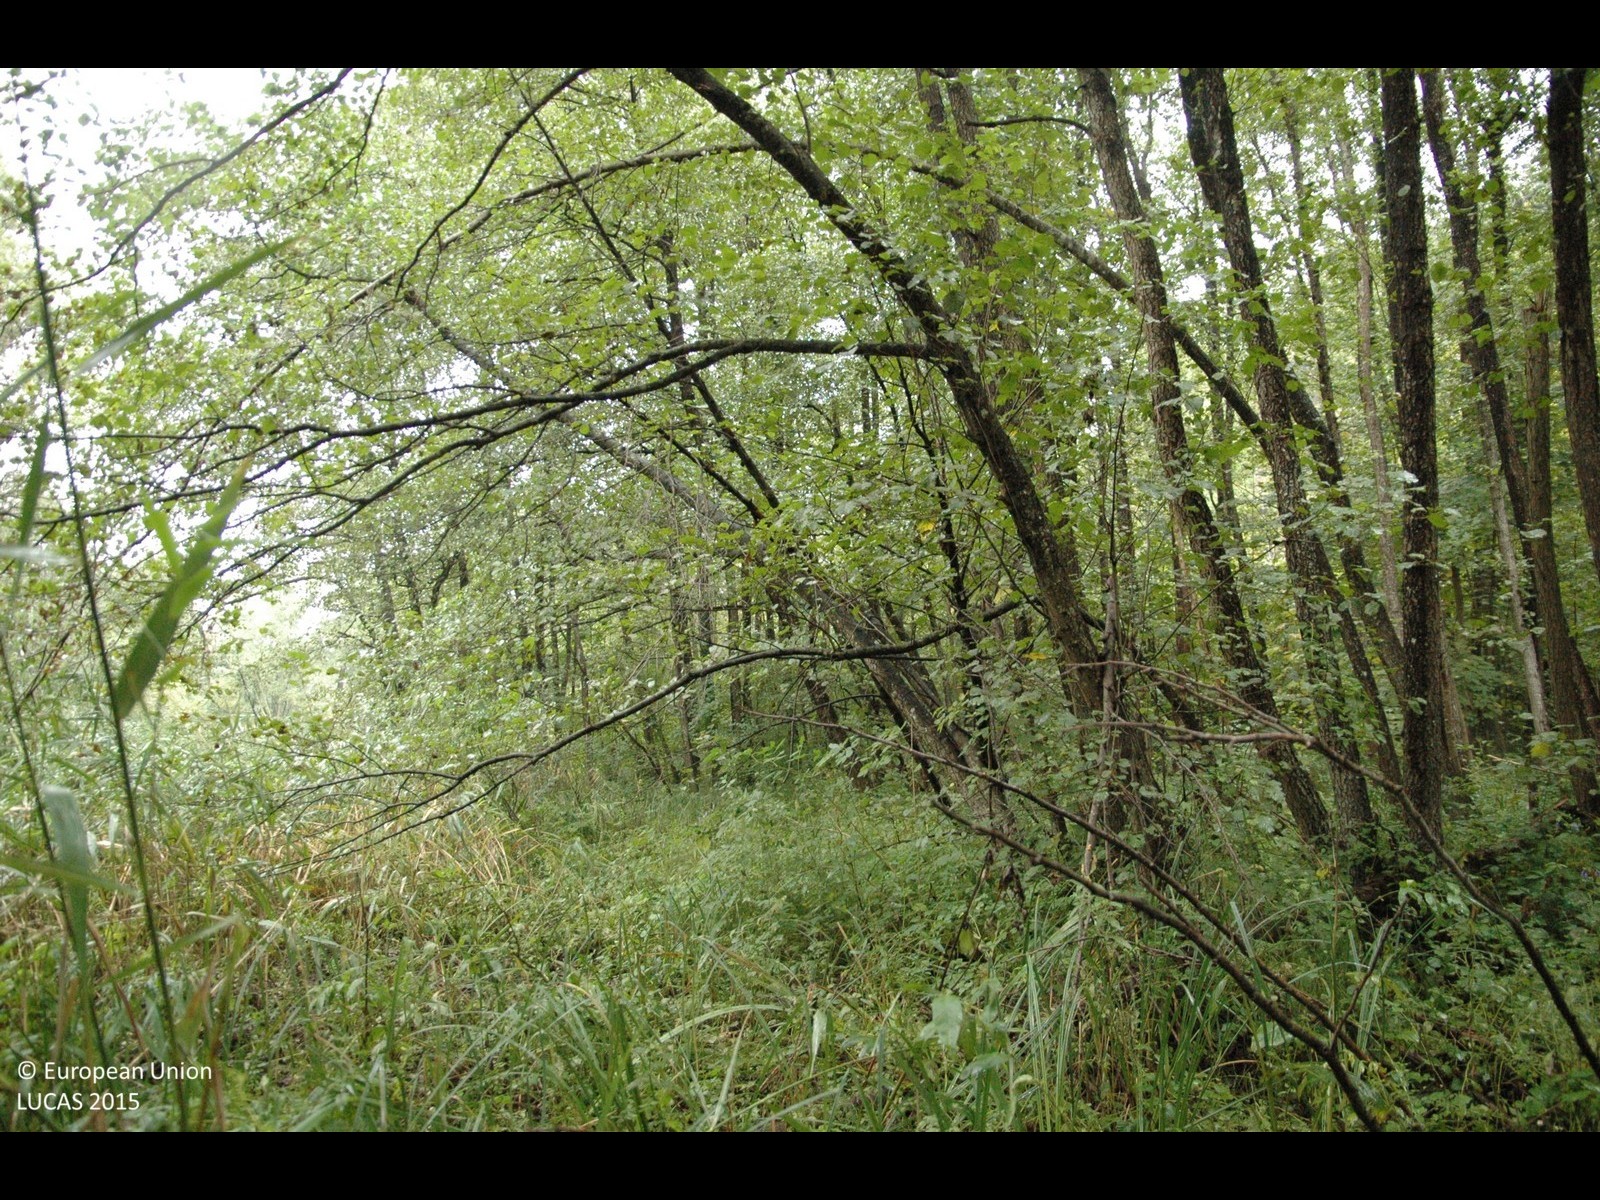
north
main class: Woodland
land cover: Broadleaved woodland
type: mesophytic deciduous forest
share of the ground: > 75 %
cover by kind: broadleaved forest trees 100 %
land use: Semi-natural and natural areas not in use
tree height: > 5 m
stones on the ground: < 10 %
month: October
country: HR
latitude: 45.1559
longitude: 15.2740
